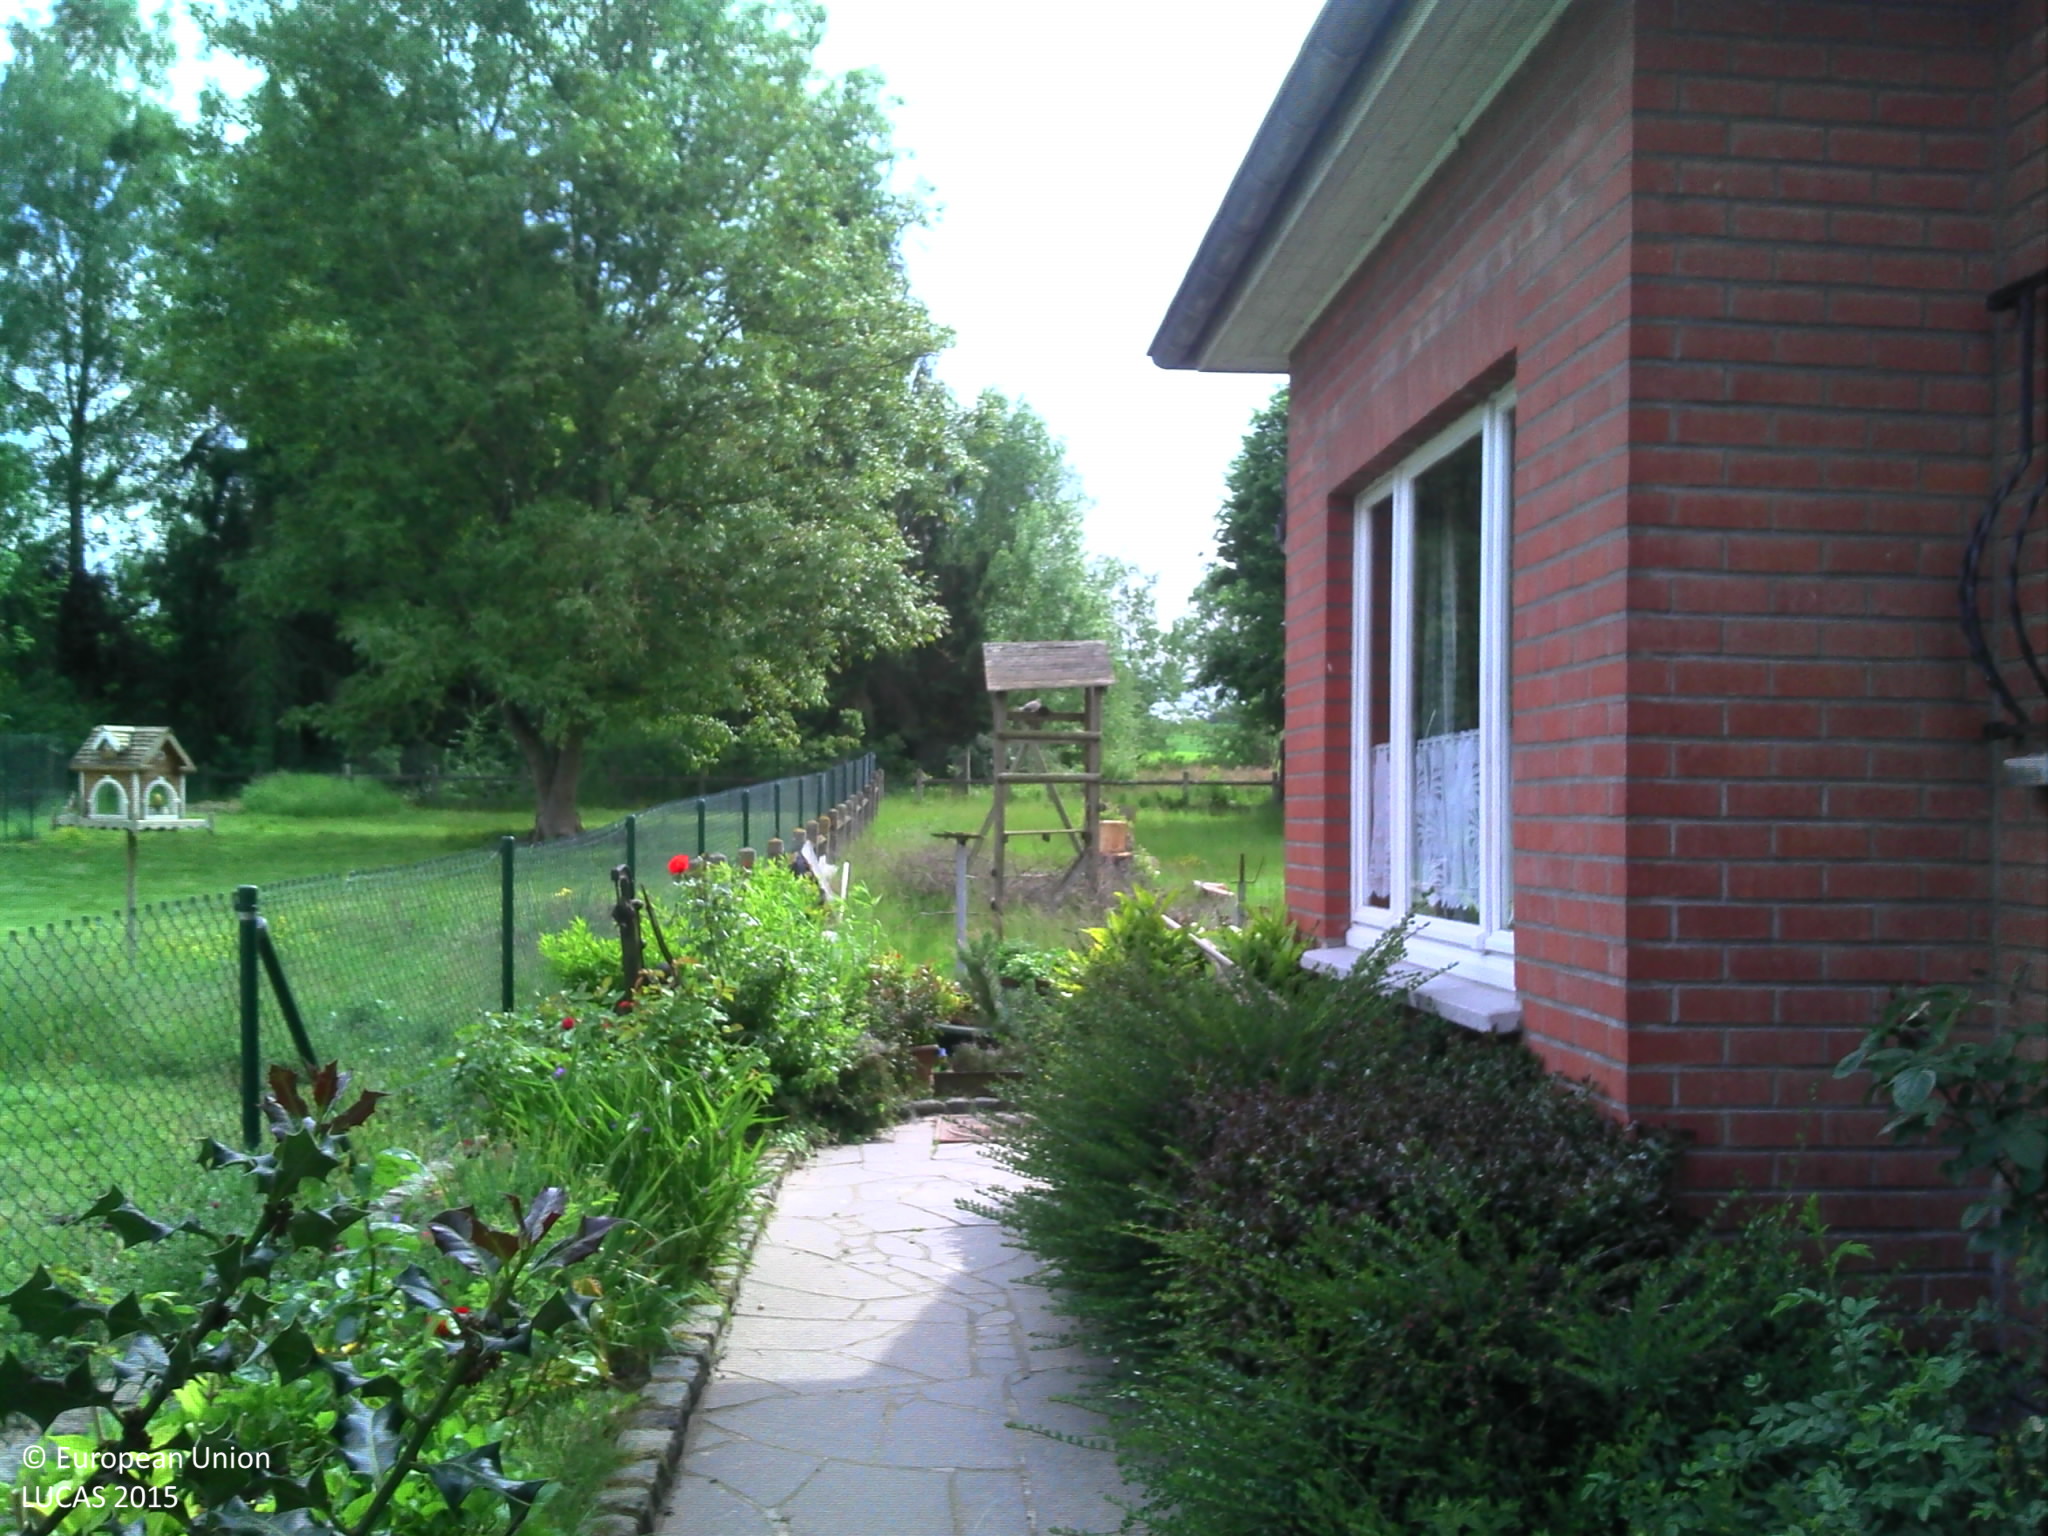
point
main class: Grassland
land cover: Grassland with sparse tree/shrub cover
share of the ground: > 75 %
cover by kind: herbaceous plants 95 %, broadleaved forest trees 5 %
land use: Residential
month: May
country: BE
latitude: 50.7808
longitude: 4.6777
